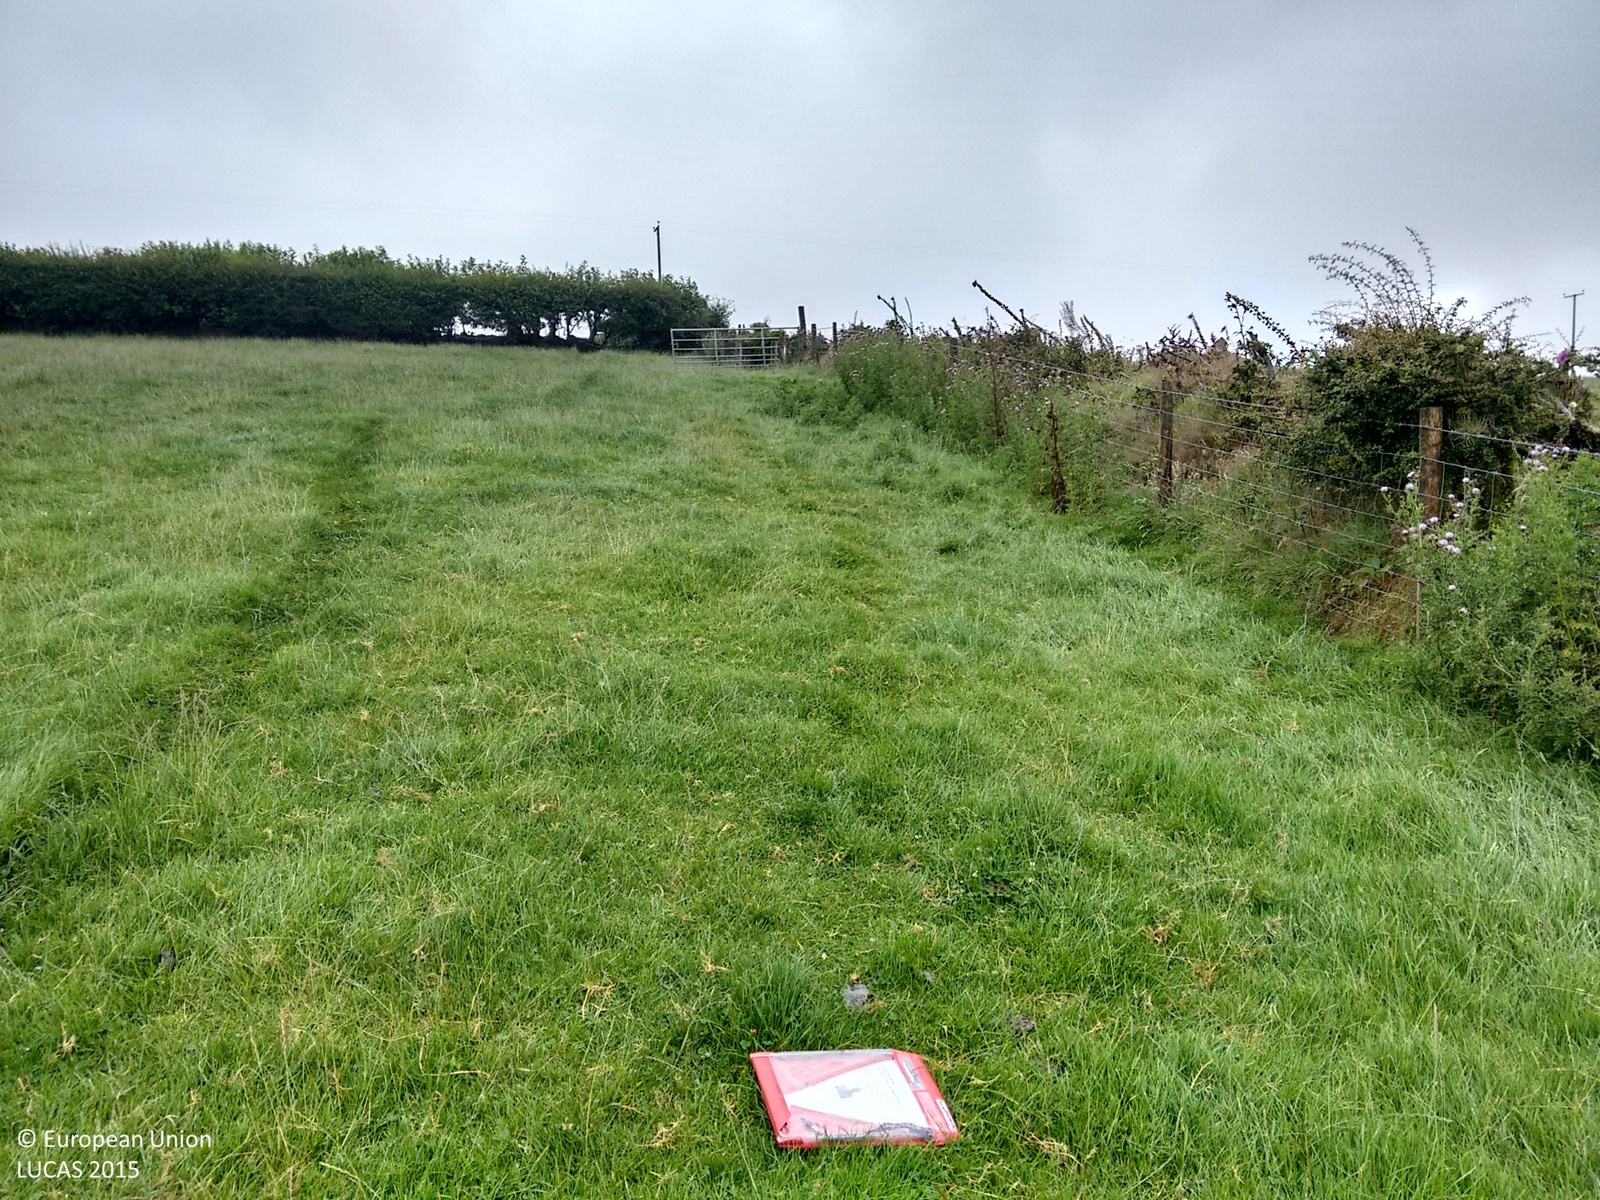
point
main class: Grassland
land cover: Grassland without tree/shrub cover
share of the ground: > 75 %
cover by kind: herbaceous plants 100 %
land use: Agriculture (excluding fallow land and kitchen gardens)
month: August
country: GB
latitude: 51.9072
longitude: -4.4511
